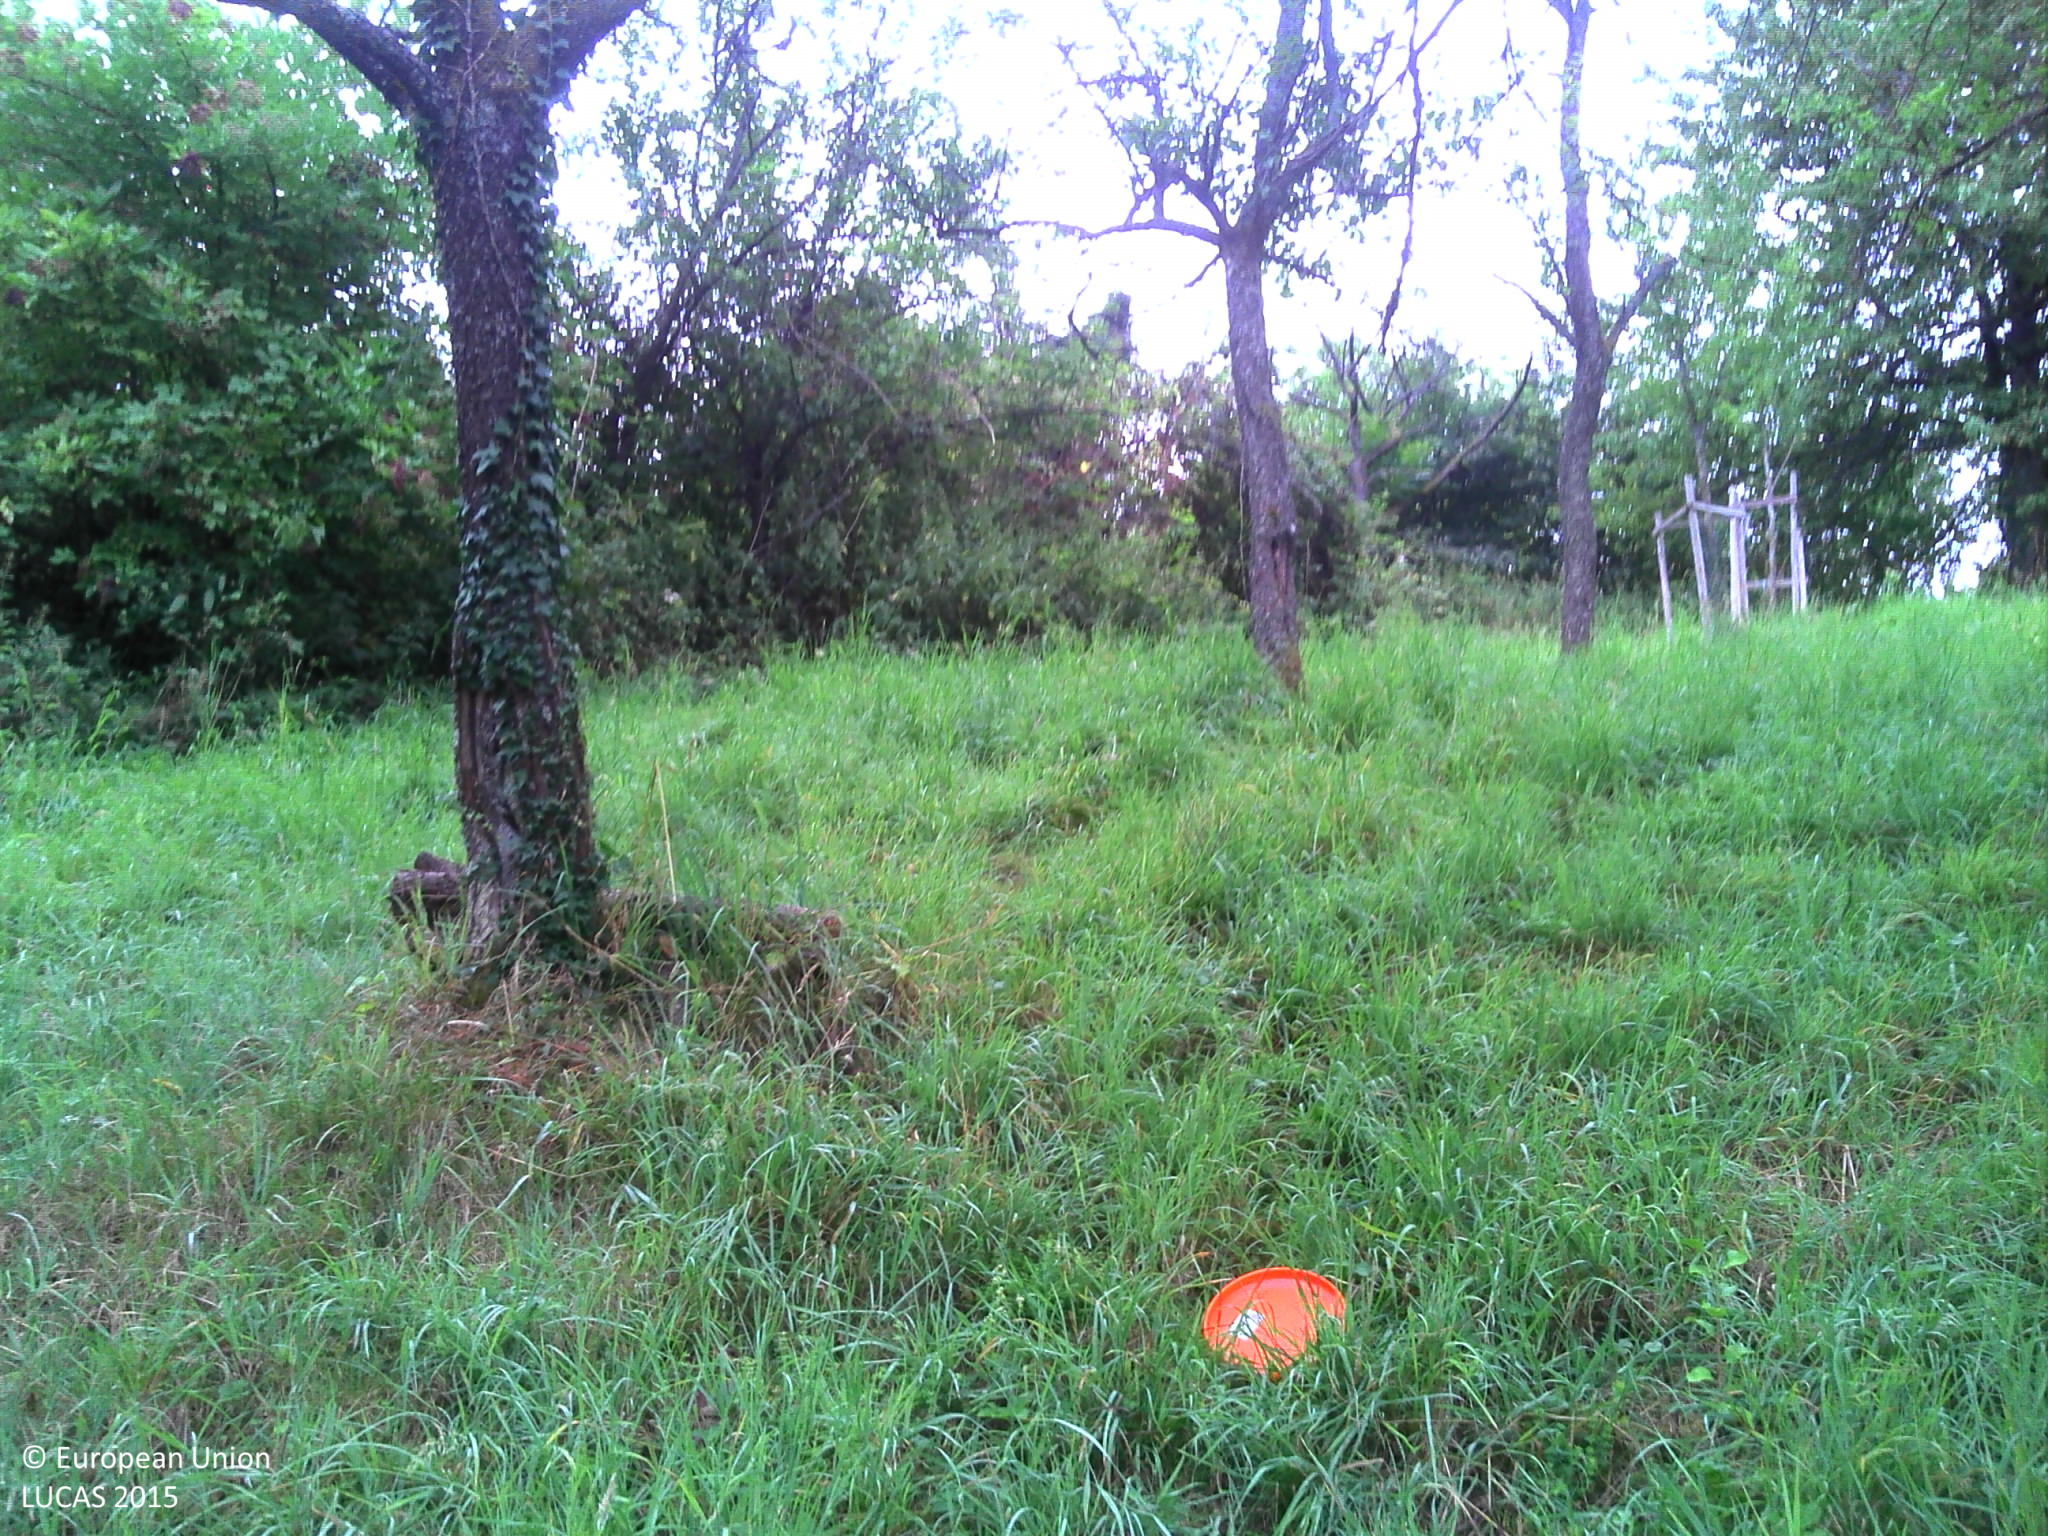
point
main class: Grassland
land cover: Grassland with sparse tree/shrub cover
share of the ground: > 75 %
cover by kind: herbaceous plants 95 %, broadleaved forest trees 5 %
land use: Agriculture (excluding fallow land and kitchen gardens)
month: August
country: FR
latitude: 48.9109
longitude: 7.3126
